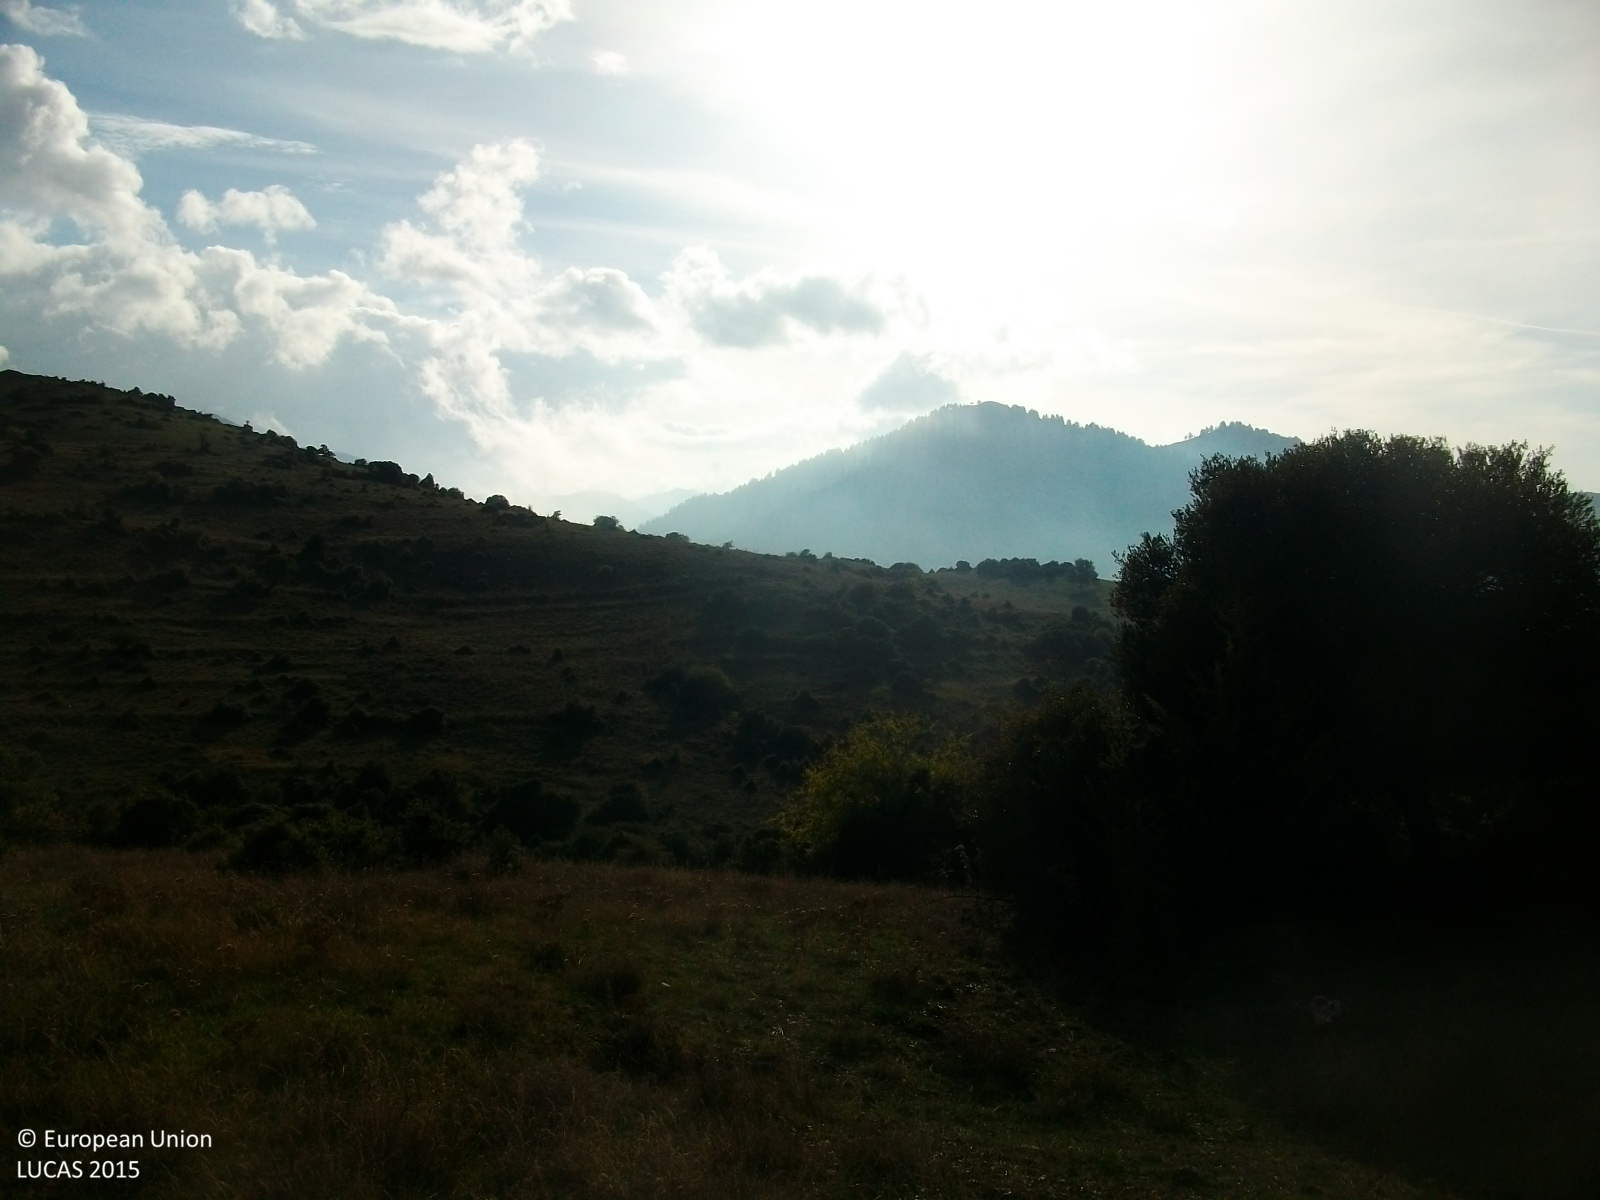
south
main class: Grassland
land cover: Grassland with sparse tree/shrub cover
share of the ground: > 75 %
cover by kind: herbaceous plants 80 %, unconsolidated bare surface 10 %, coniferous forest trees 5 %, shrubs 5 %
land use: Semi-natural and natural areas not in use
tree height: < 5 m
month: October
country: GR
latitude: 37.8860
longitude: 22.3950
